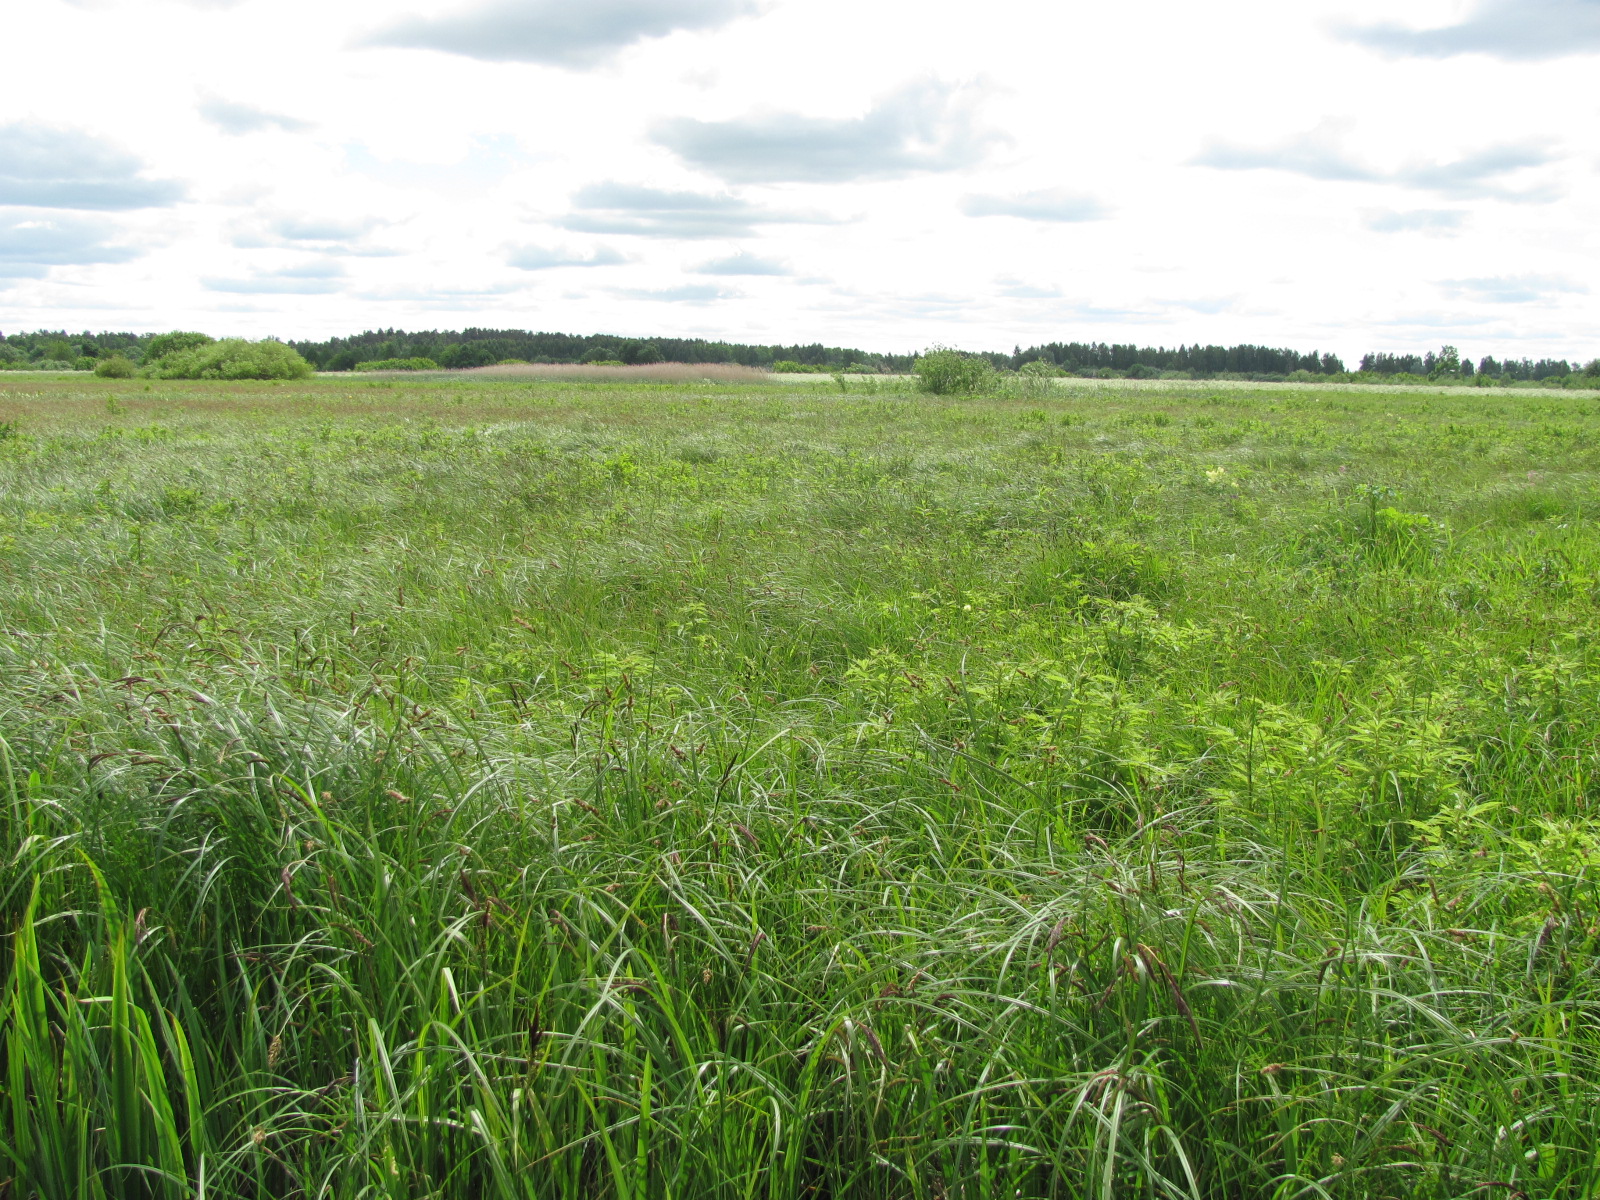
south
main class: Grassland
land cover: Grassland without tree/shrub cover
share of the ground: > 75 %
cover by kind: herbaceous plants 100 %
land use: Semi-natural and natural areas not in use
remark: Temporary flooded
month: June
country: LV
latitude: 56.6440
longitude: 23.7946
